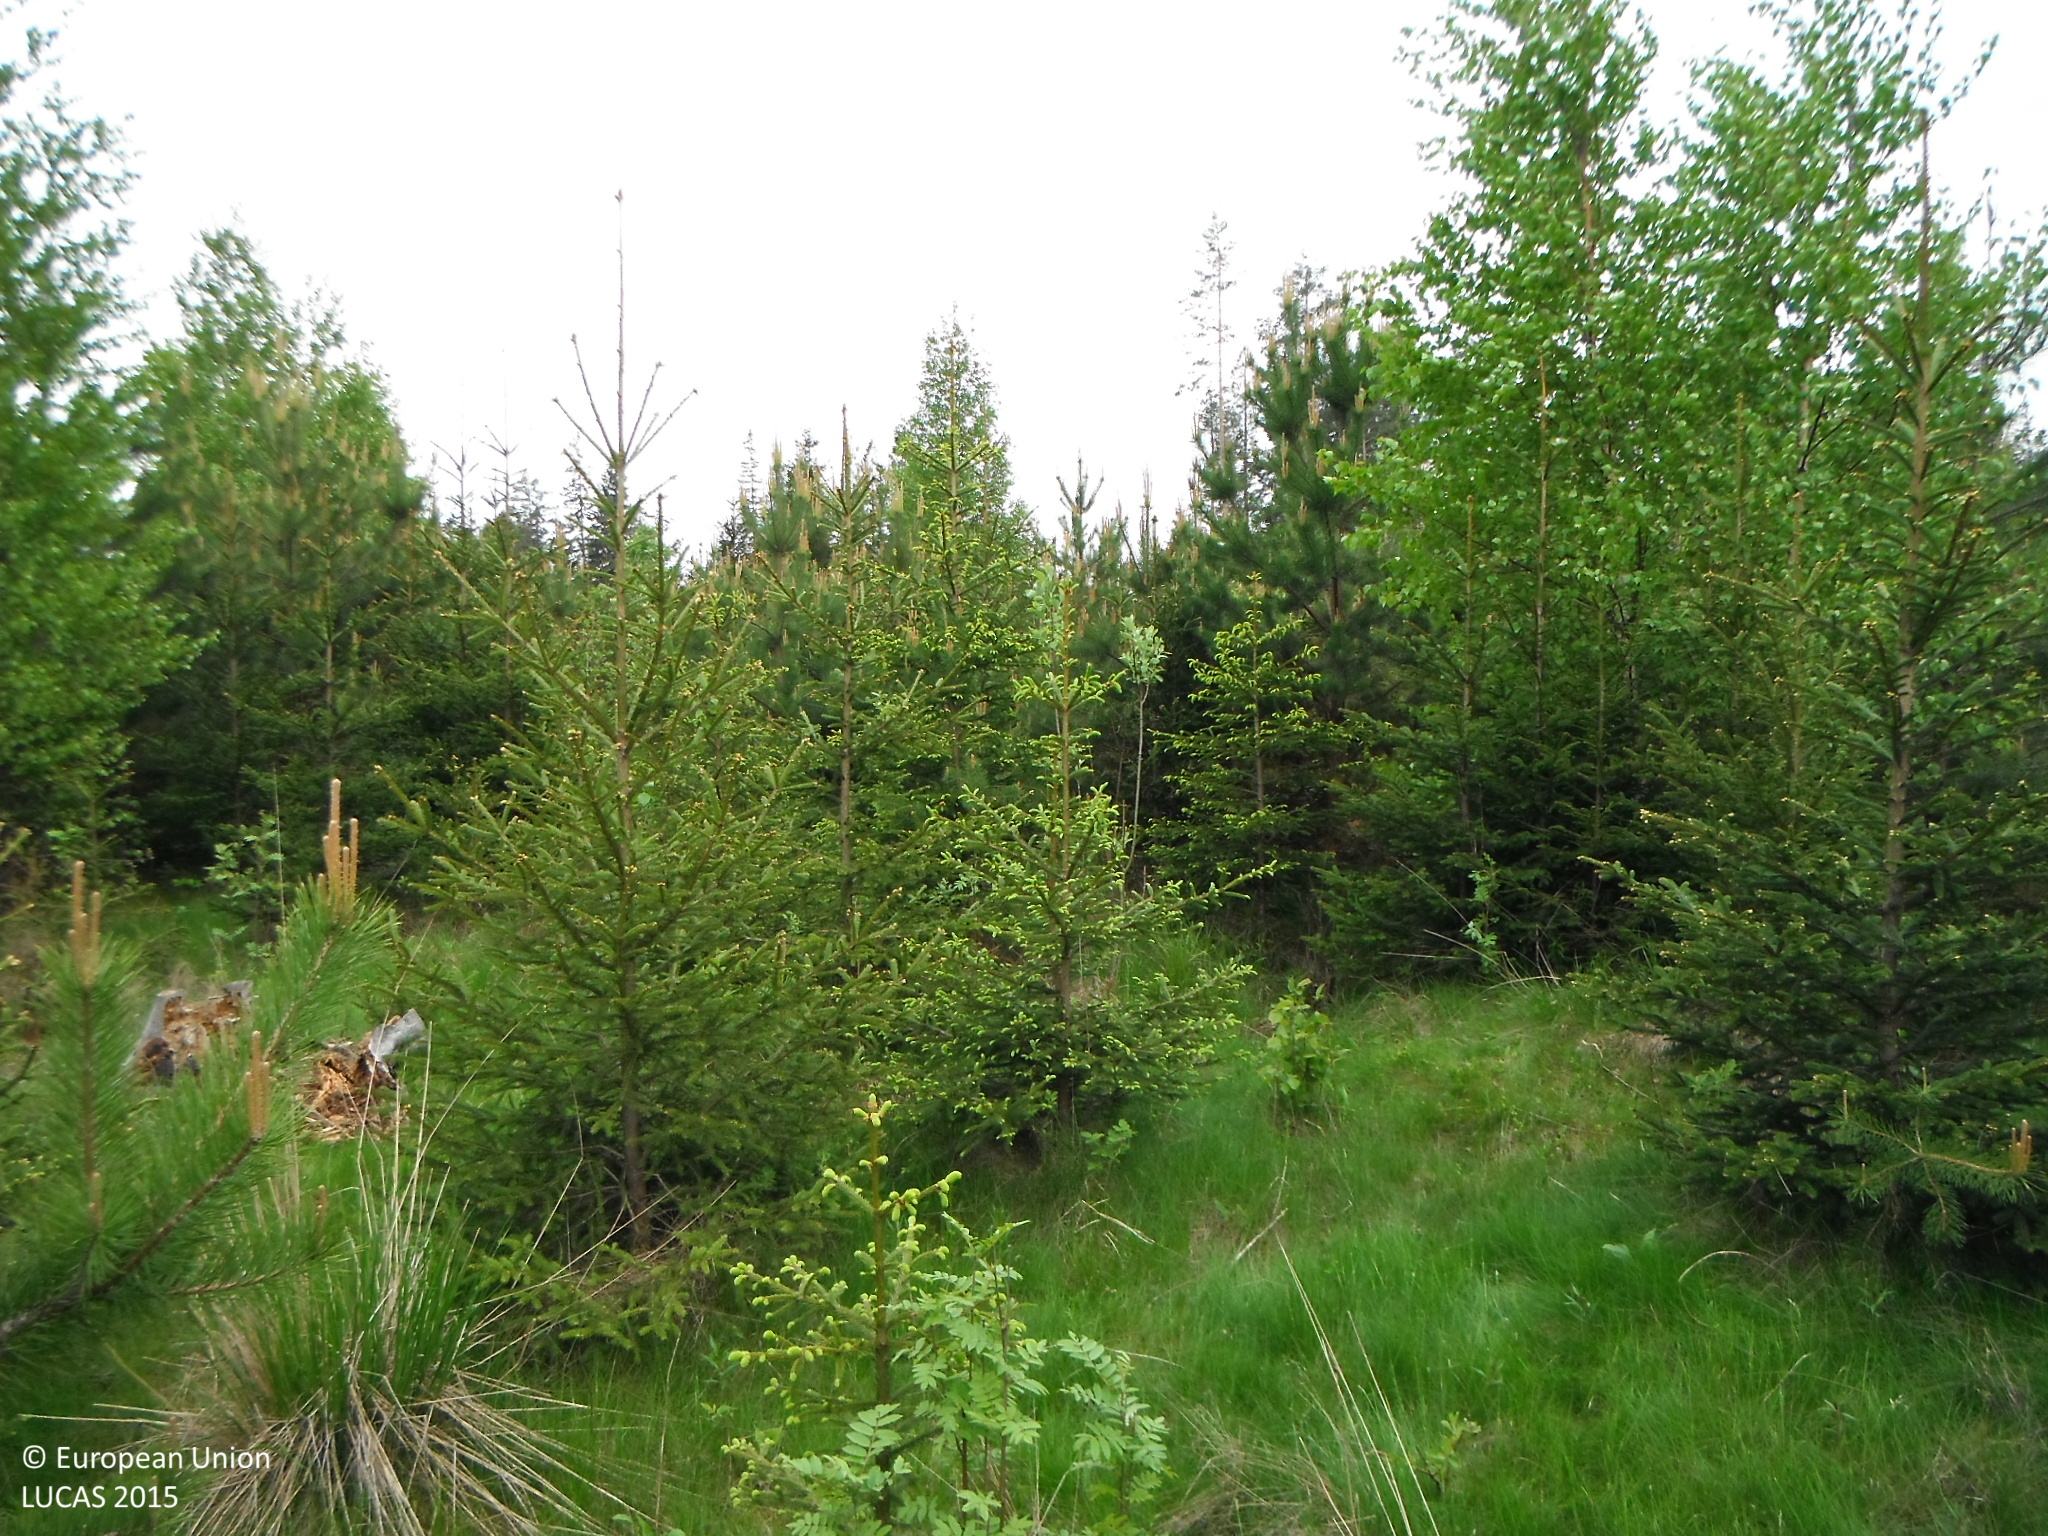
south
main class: Woodland
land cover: Pine dominated mixed woodland
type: alpine coniferous forest
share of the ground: > 75 %
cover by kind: coniferous forest trees 50 %, broadleaved forest trees 25 %, herbaceous plants 15 %, lichens and mosses 5 %, consolidated bare surface 5 %
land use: Forestry
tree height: < 5 m
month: May
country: SK
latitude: 49.2227
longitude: 20.3462
